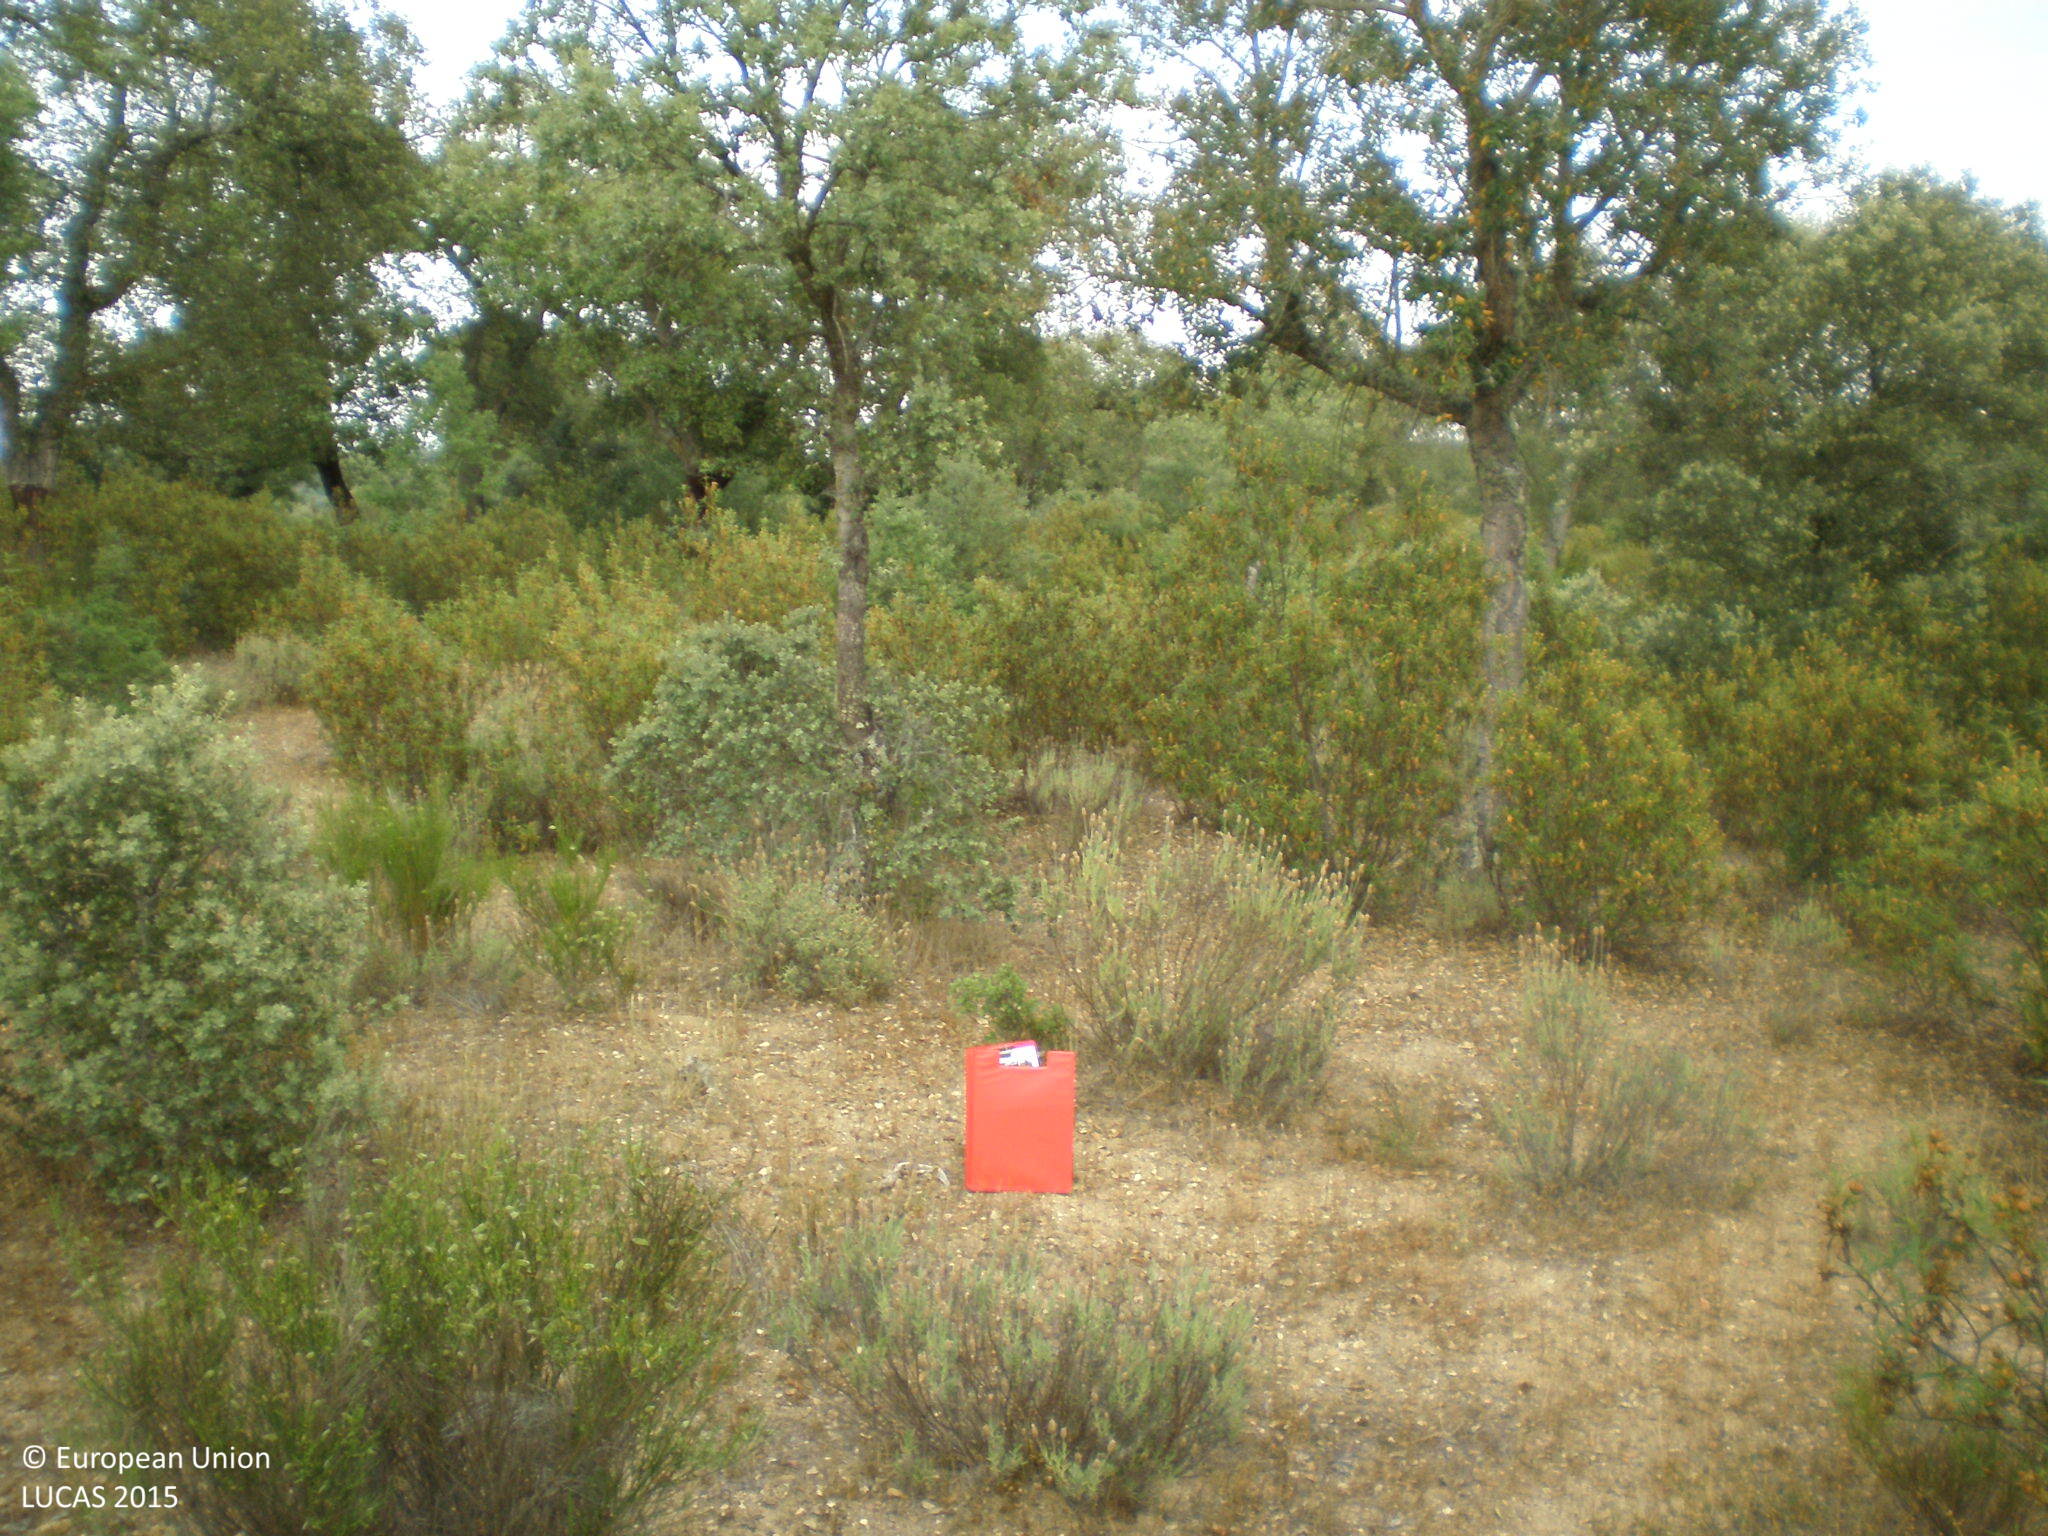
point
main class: Woodland
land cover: Broadleaved woodland
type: broadleaved evergreen forest
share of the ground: 25 - 50 %
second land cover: Grassland without tree/shrub cover
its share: 50 - 75 %
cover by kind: herbaceous plants 60 %, broadleaved forest trees 40 %
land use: Forestry
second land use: Agriculture (excluding fallow land and kitchen gardens)
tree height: < 5 m
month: June
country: ES
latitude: 41.1515
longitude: -5.7753
